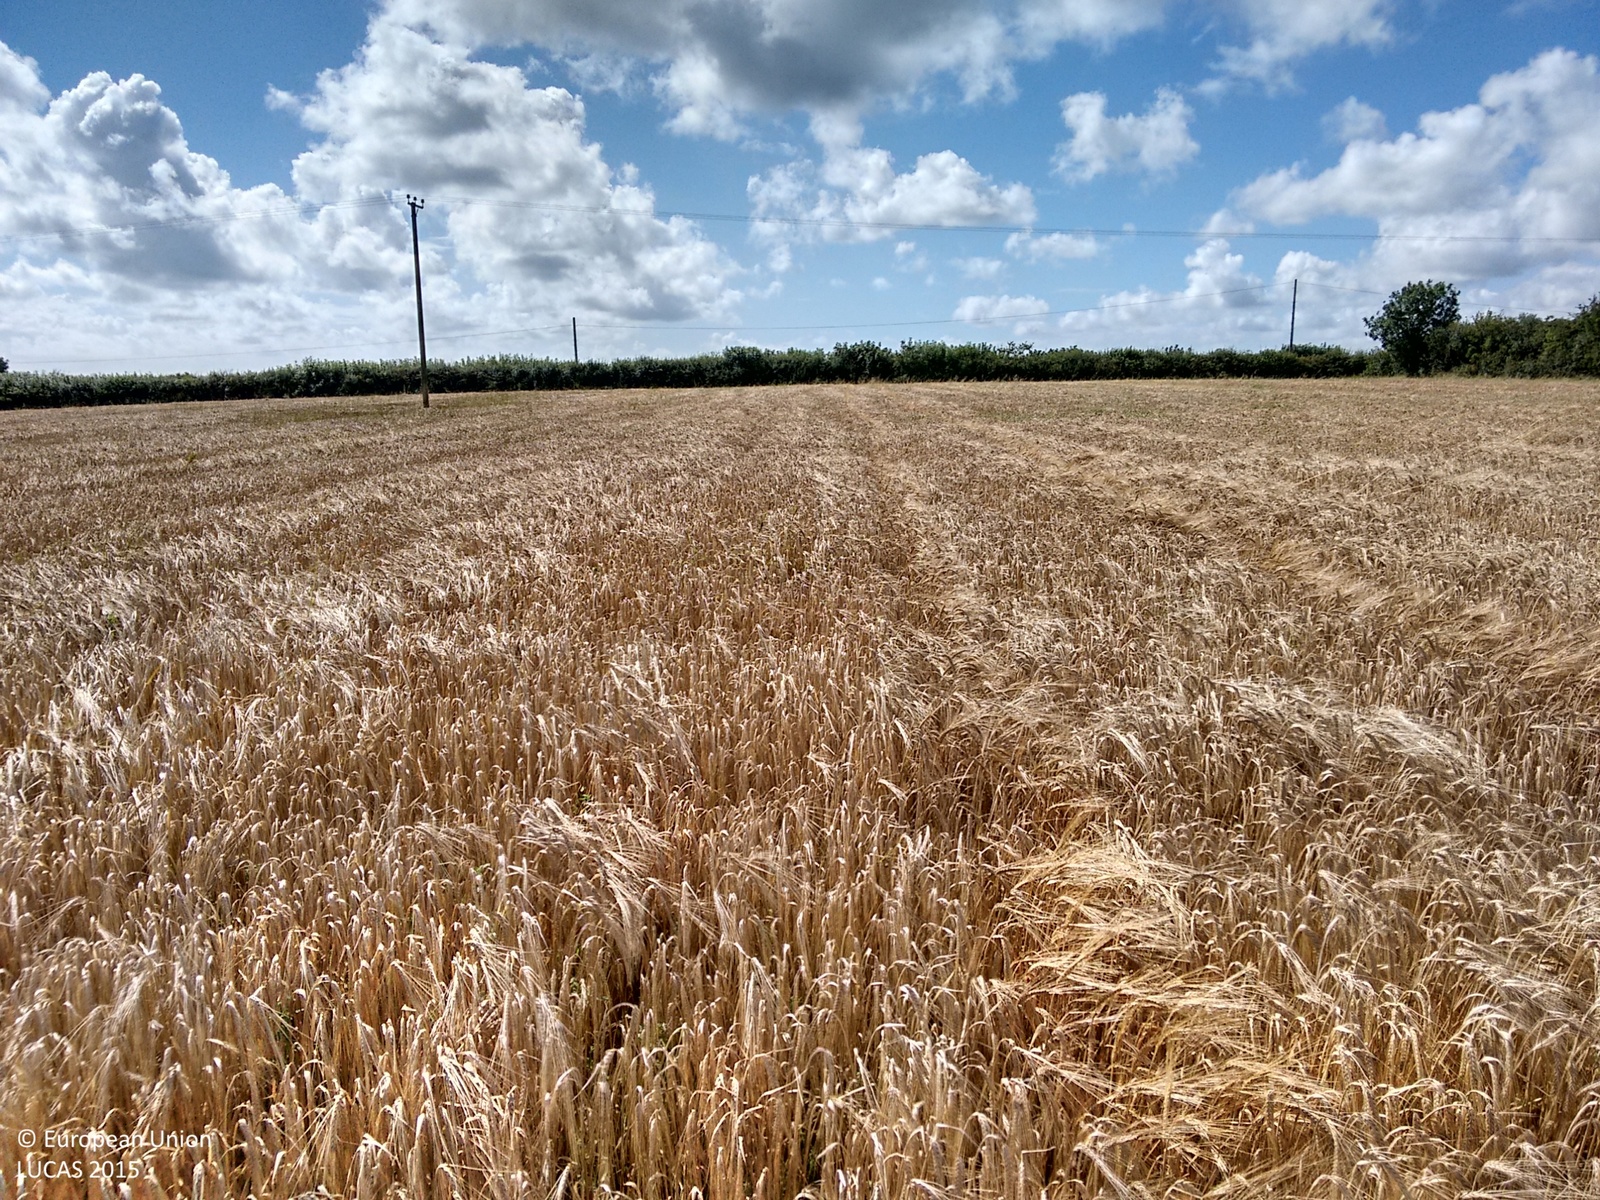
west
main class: Cropland
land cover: Barley
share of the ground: > 75 %
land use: Agriculture (excluding fallow land and kitchen gardens)
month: August
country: GB
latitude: 51.8678
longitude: -4.7652
